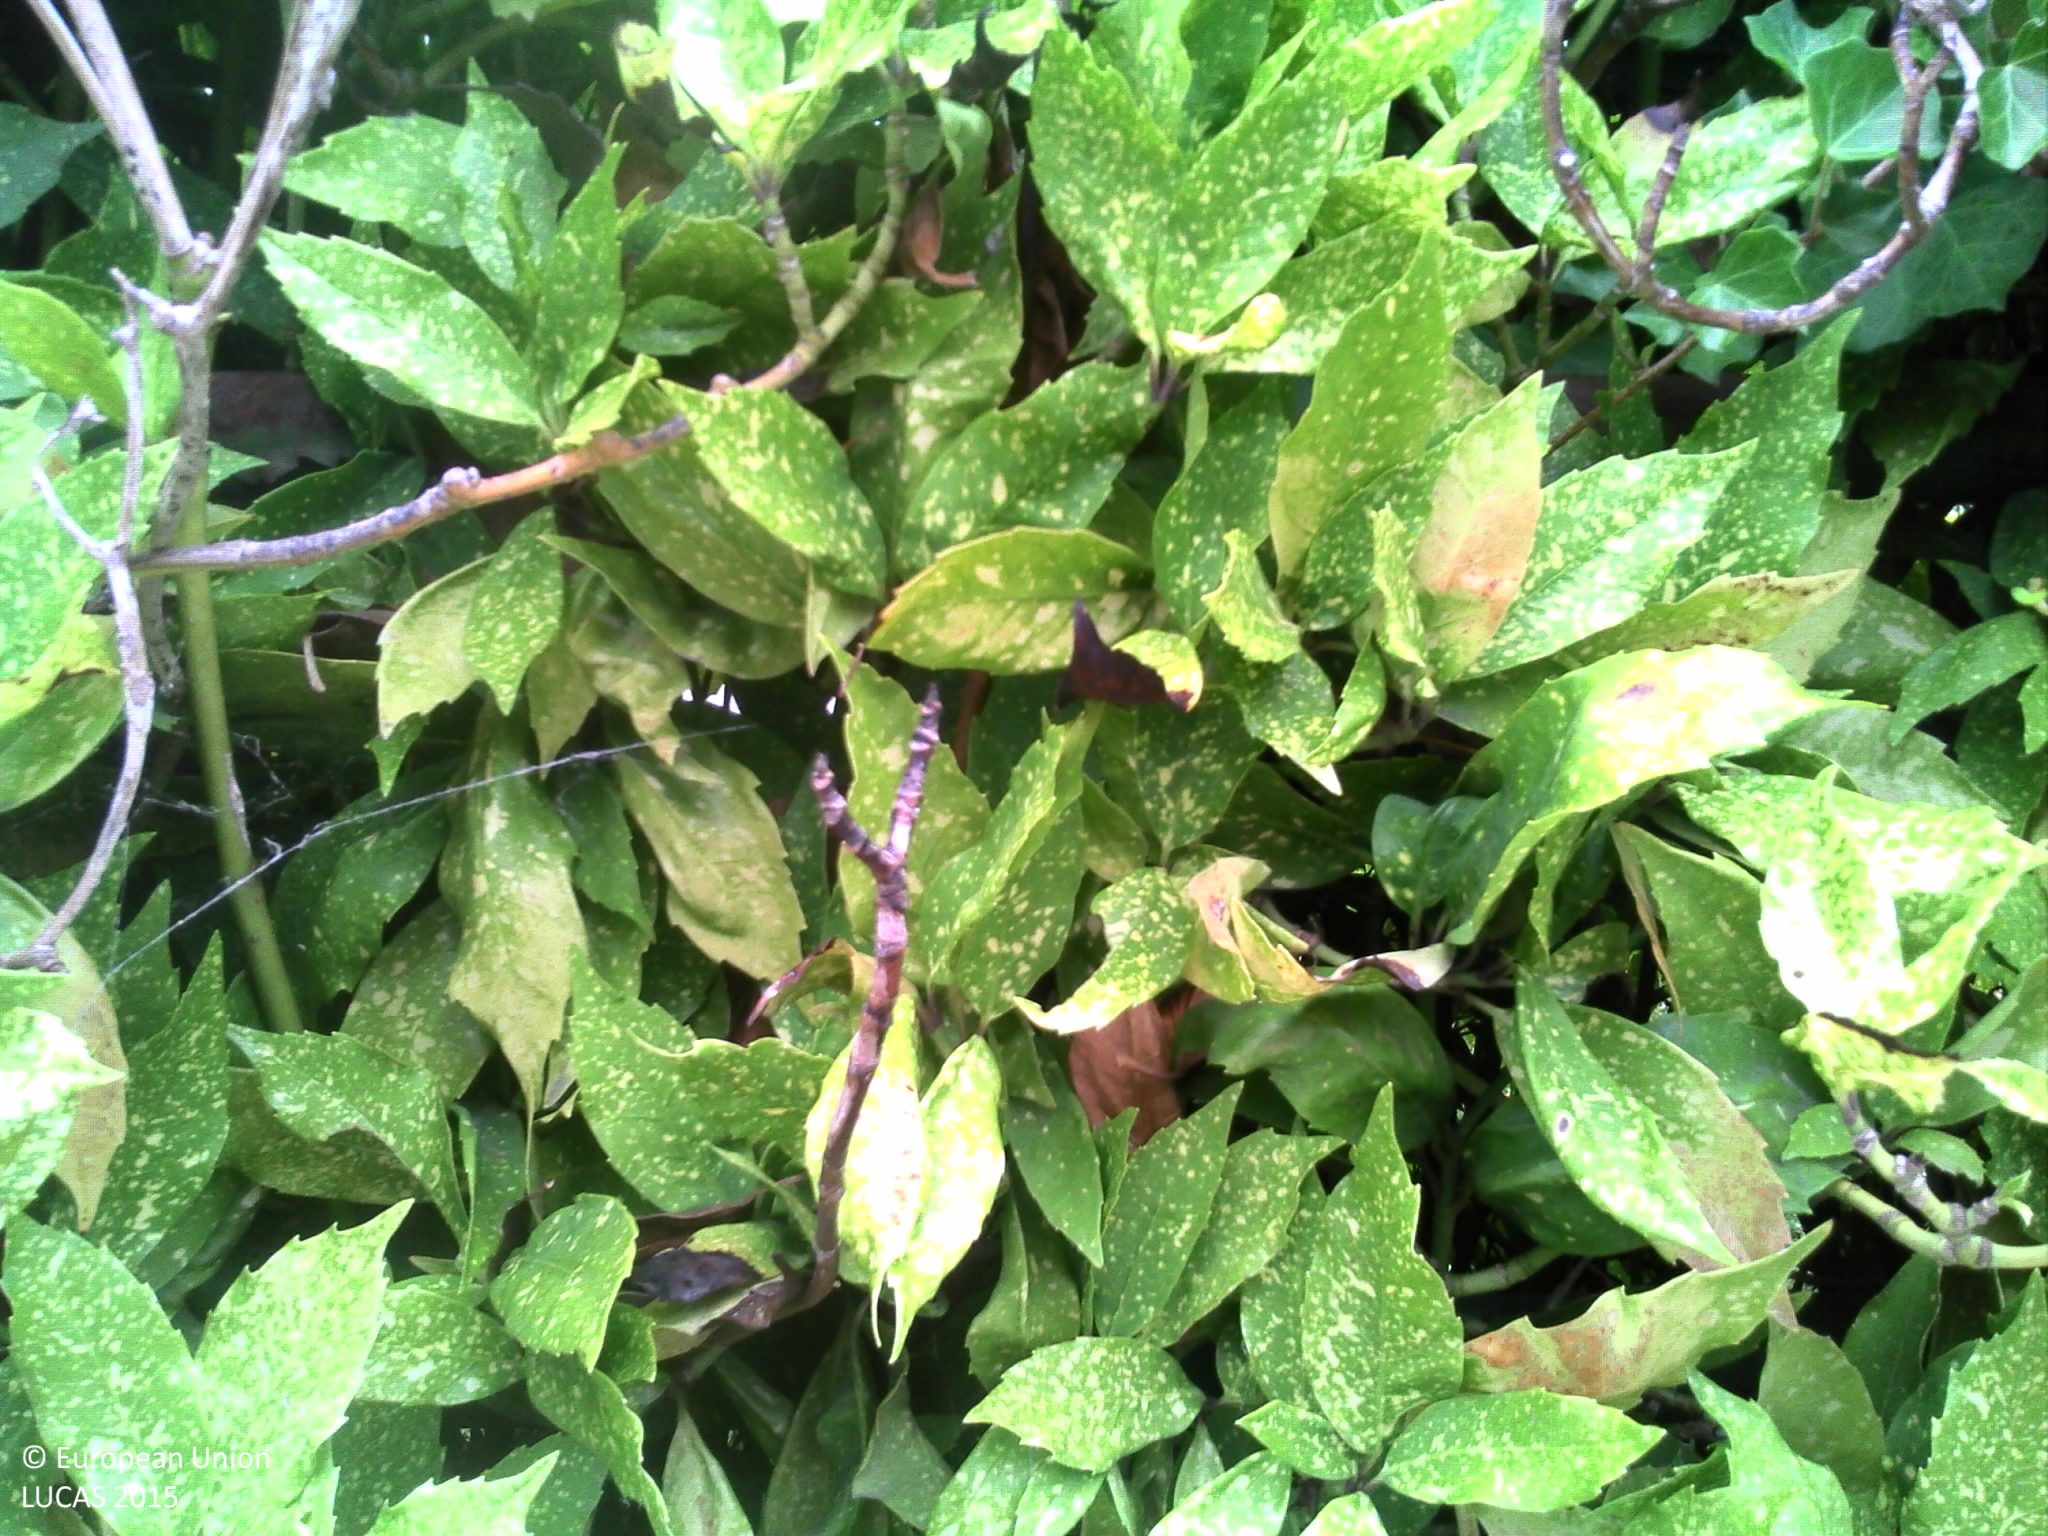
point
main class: Woodland
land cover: Broadleaved woodland
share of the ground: > 75 %
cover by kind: broadleaved forest trees 100 %
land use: Residential
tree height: > 5 m
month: July
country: FR
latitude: 47.9125
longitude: 1.9732
